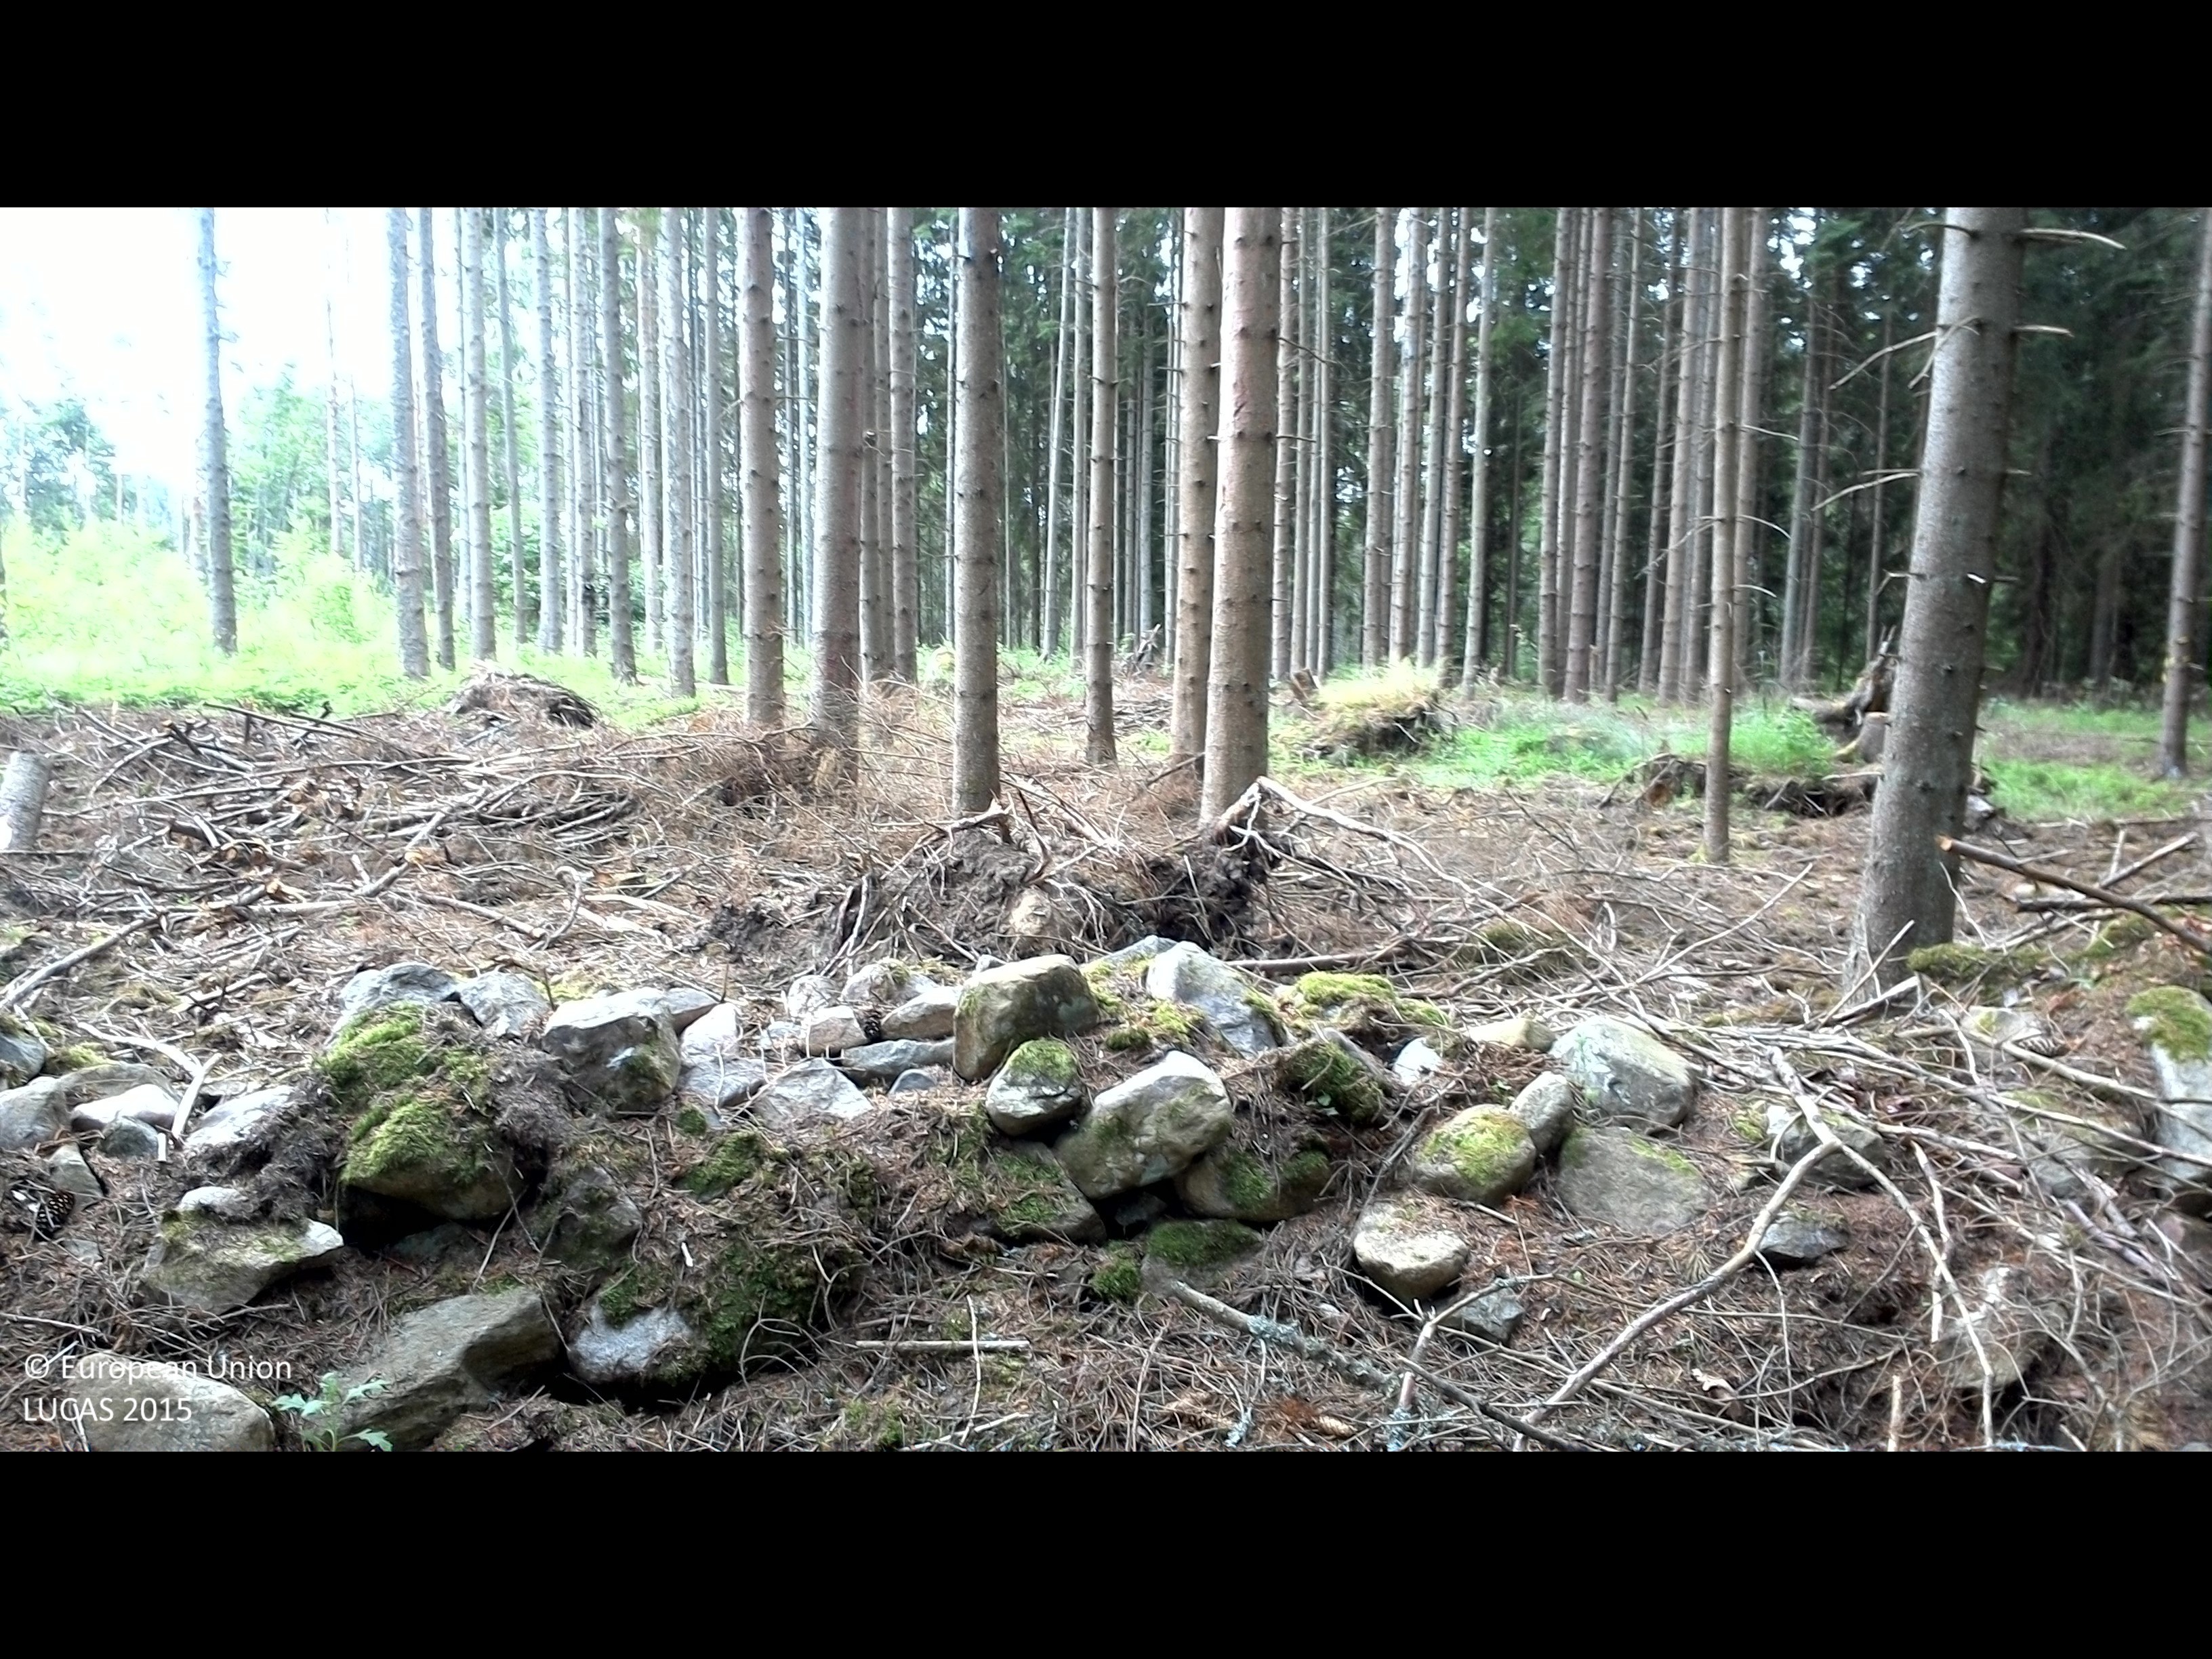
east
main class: Woodland
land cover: Spruce dominated coniferous woodland
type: boreal forest
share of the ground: 50 - 75 %
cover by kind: coniferous forest trees 70 %, lichens and mosses 25 %, herbaceous plants 5 %
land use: Forestry
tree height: > 5 m
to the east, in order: Spruce dominated coniferous woodland; Dry stone walls; Spruce dominated coniferous woodland; Dry stone walls; Spruce dominated coniferous woodland; Pine dominated mixed woodland
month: July
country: SE
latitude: 56.5150
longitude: 14.7270
